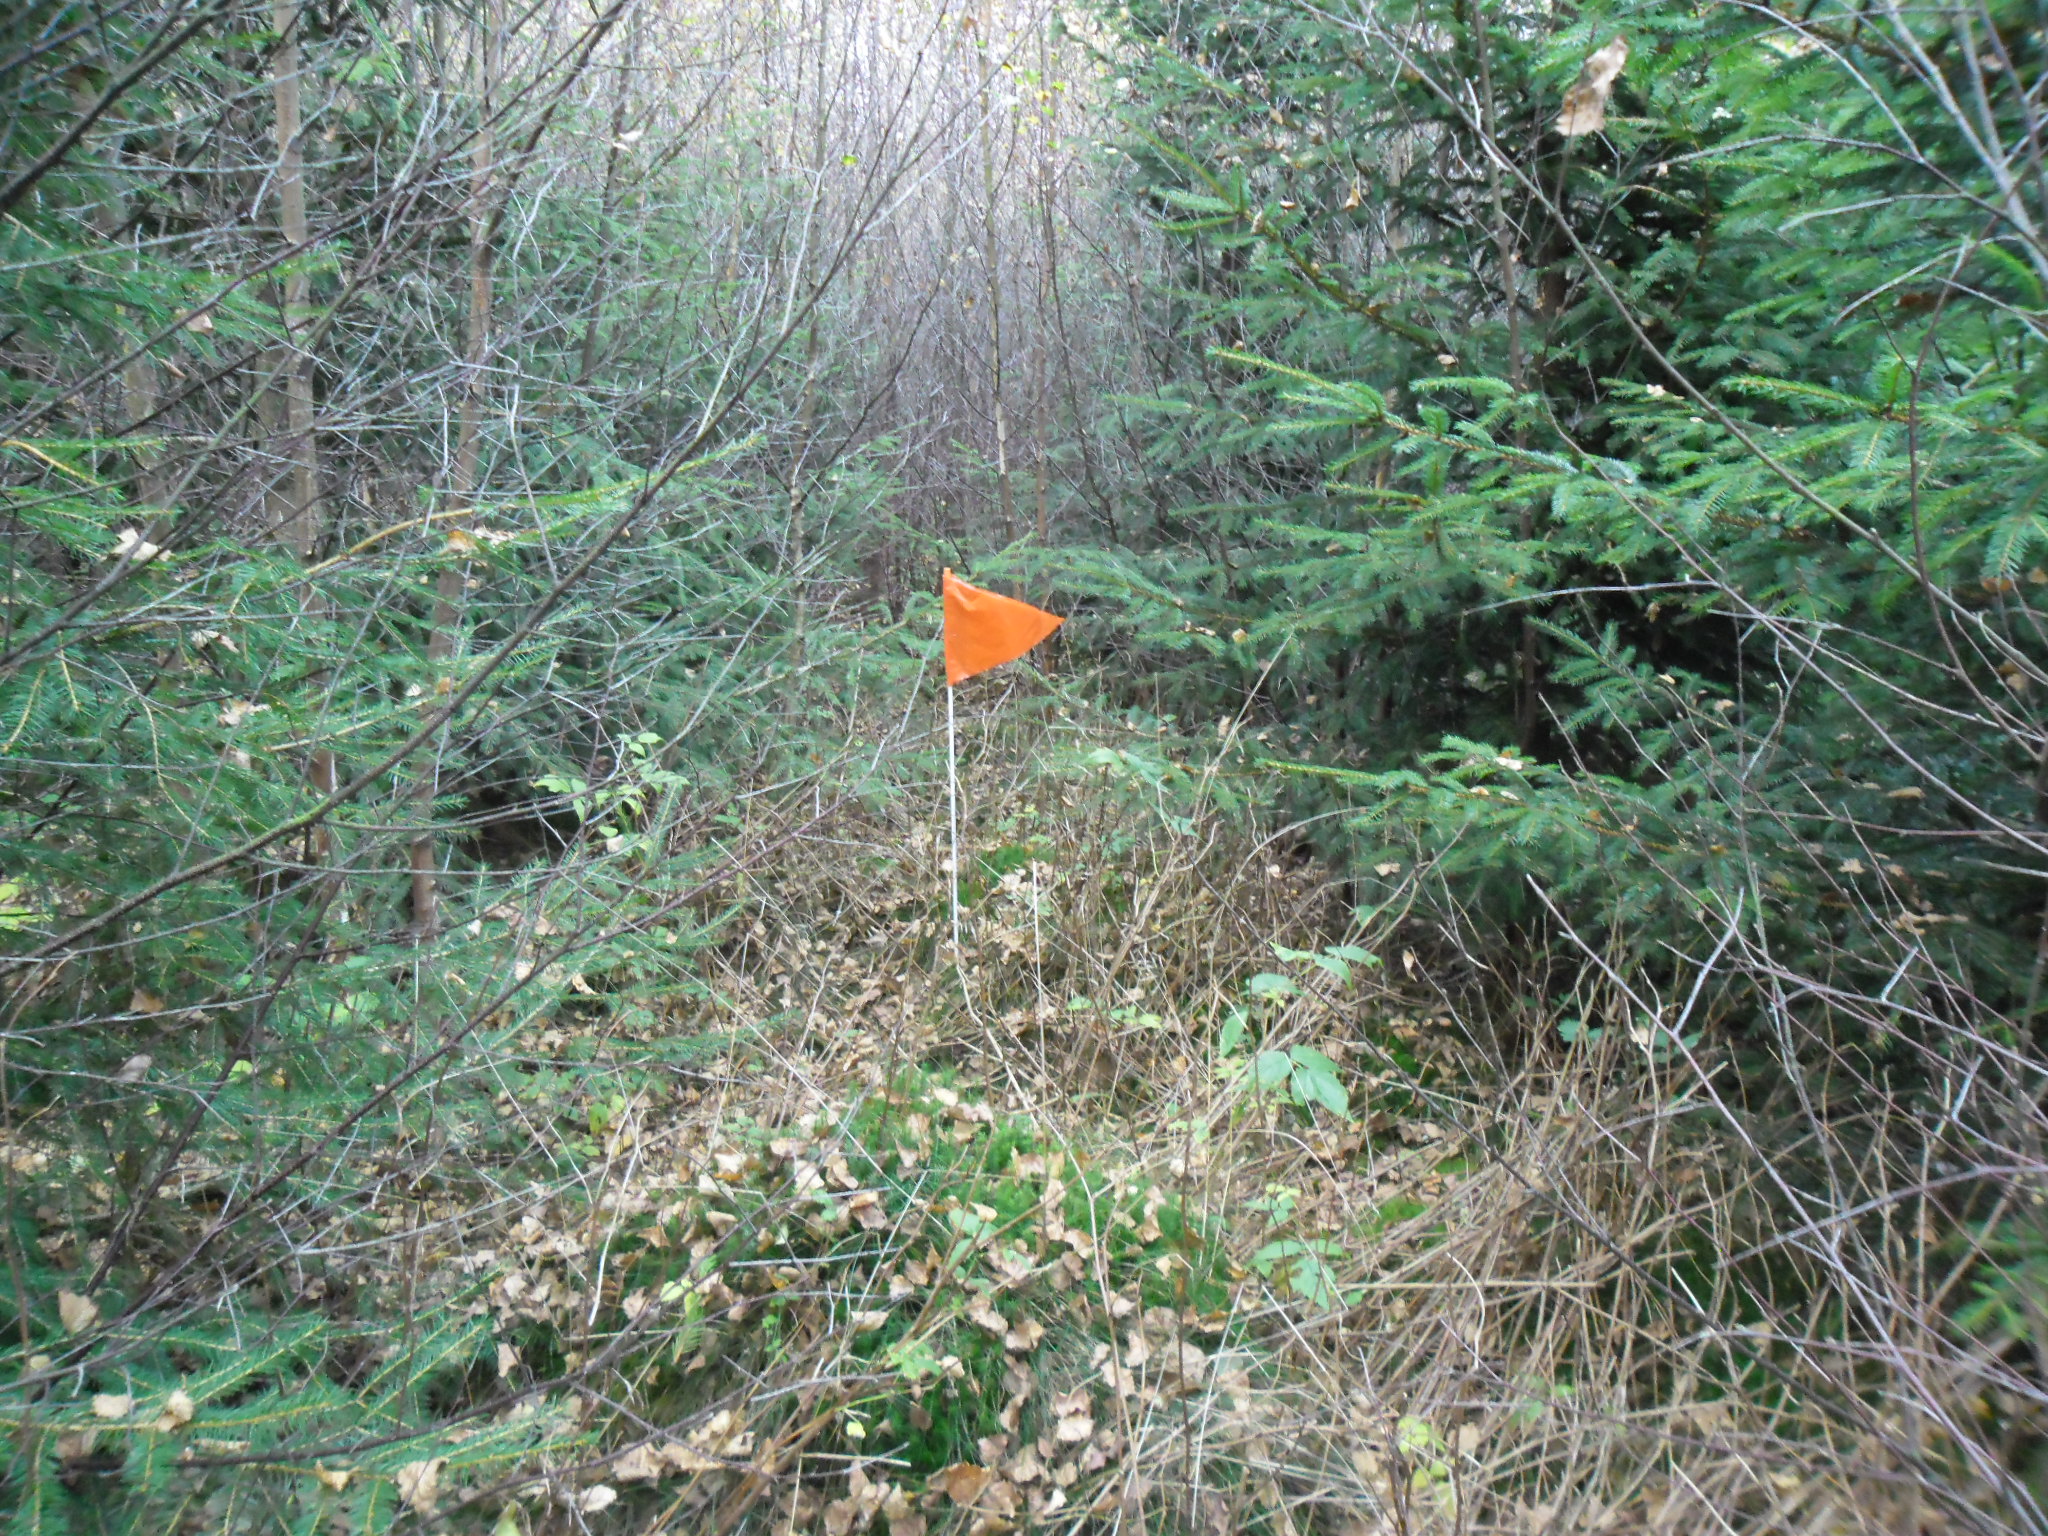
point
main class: Woodland
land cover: Spruce dominated mixed woodland
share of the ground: > 75 %
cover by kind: coniferous forest trees 65 %, broadleaved forest trees 35 %
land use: Forestry
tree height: < 5 m
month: October
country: SE
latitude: 56.6359
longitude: 13.1109
